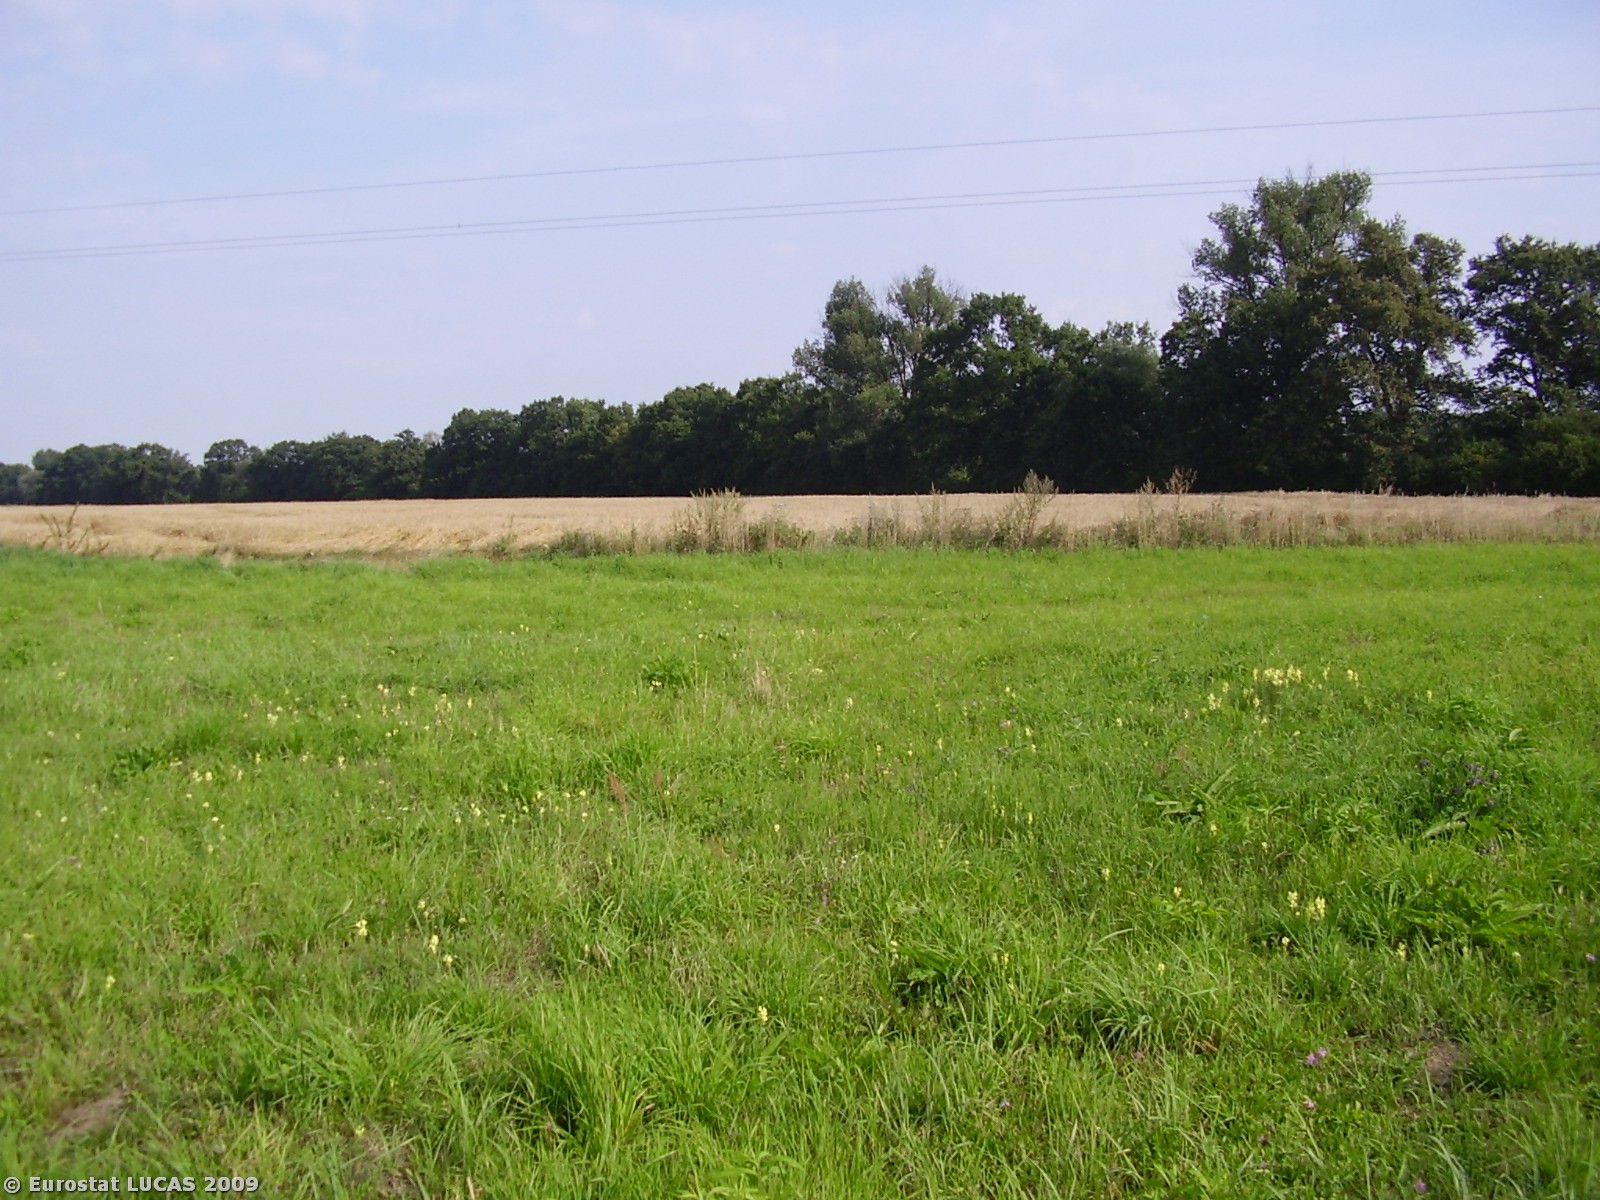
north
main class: Grassland
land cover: Grassland without tree/shrub cover
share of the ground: > 75 %
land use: Agriculture (excluding fallow land and kitchen gardens)
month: August
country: PL
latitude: 51.6591
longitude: 16.1502
